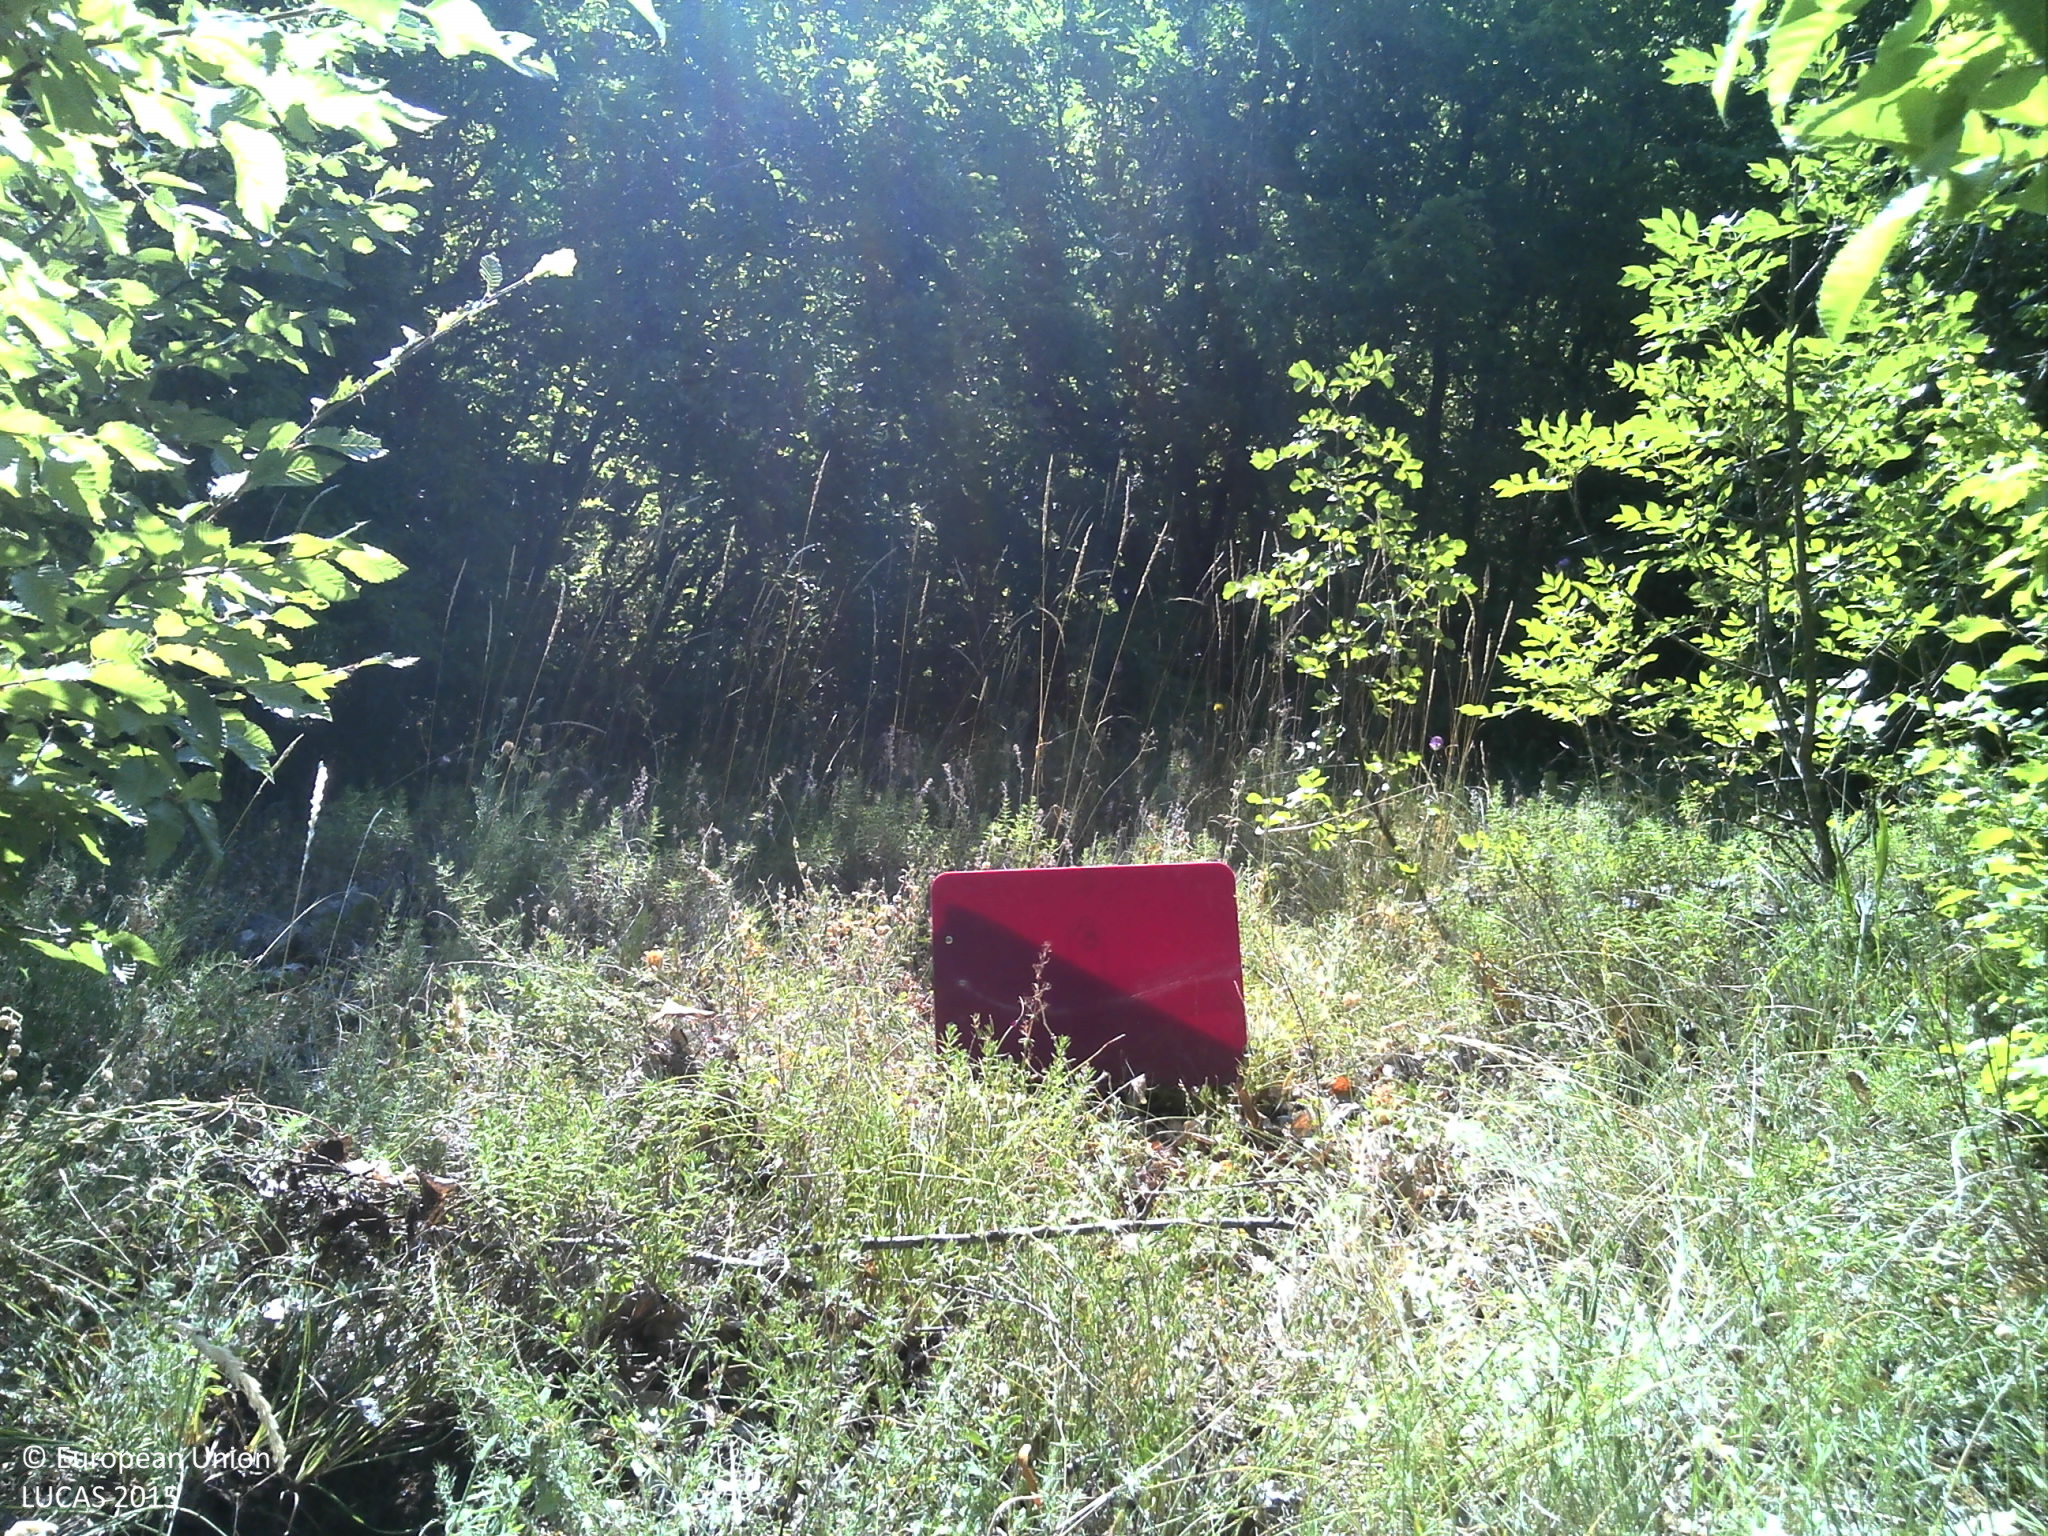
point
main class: Woodland
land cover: Broadleaved woodland
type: thermophilous deciduous forest
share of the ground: 25 - 50 %
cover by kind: shrubs 45 %, broadleaved forest trees 40 %, herbaceous plants 10 %, consolidated bare surface 5 %
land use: Semi-natural and natural areas not in use
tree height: > 5 m
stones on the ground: < 10 %
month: July
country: HR
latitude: 43.5342
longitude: 17.0082
